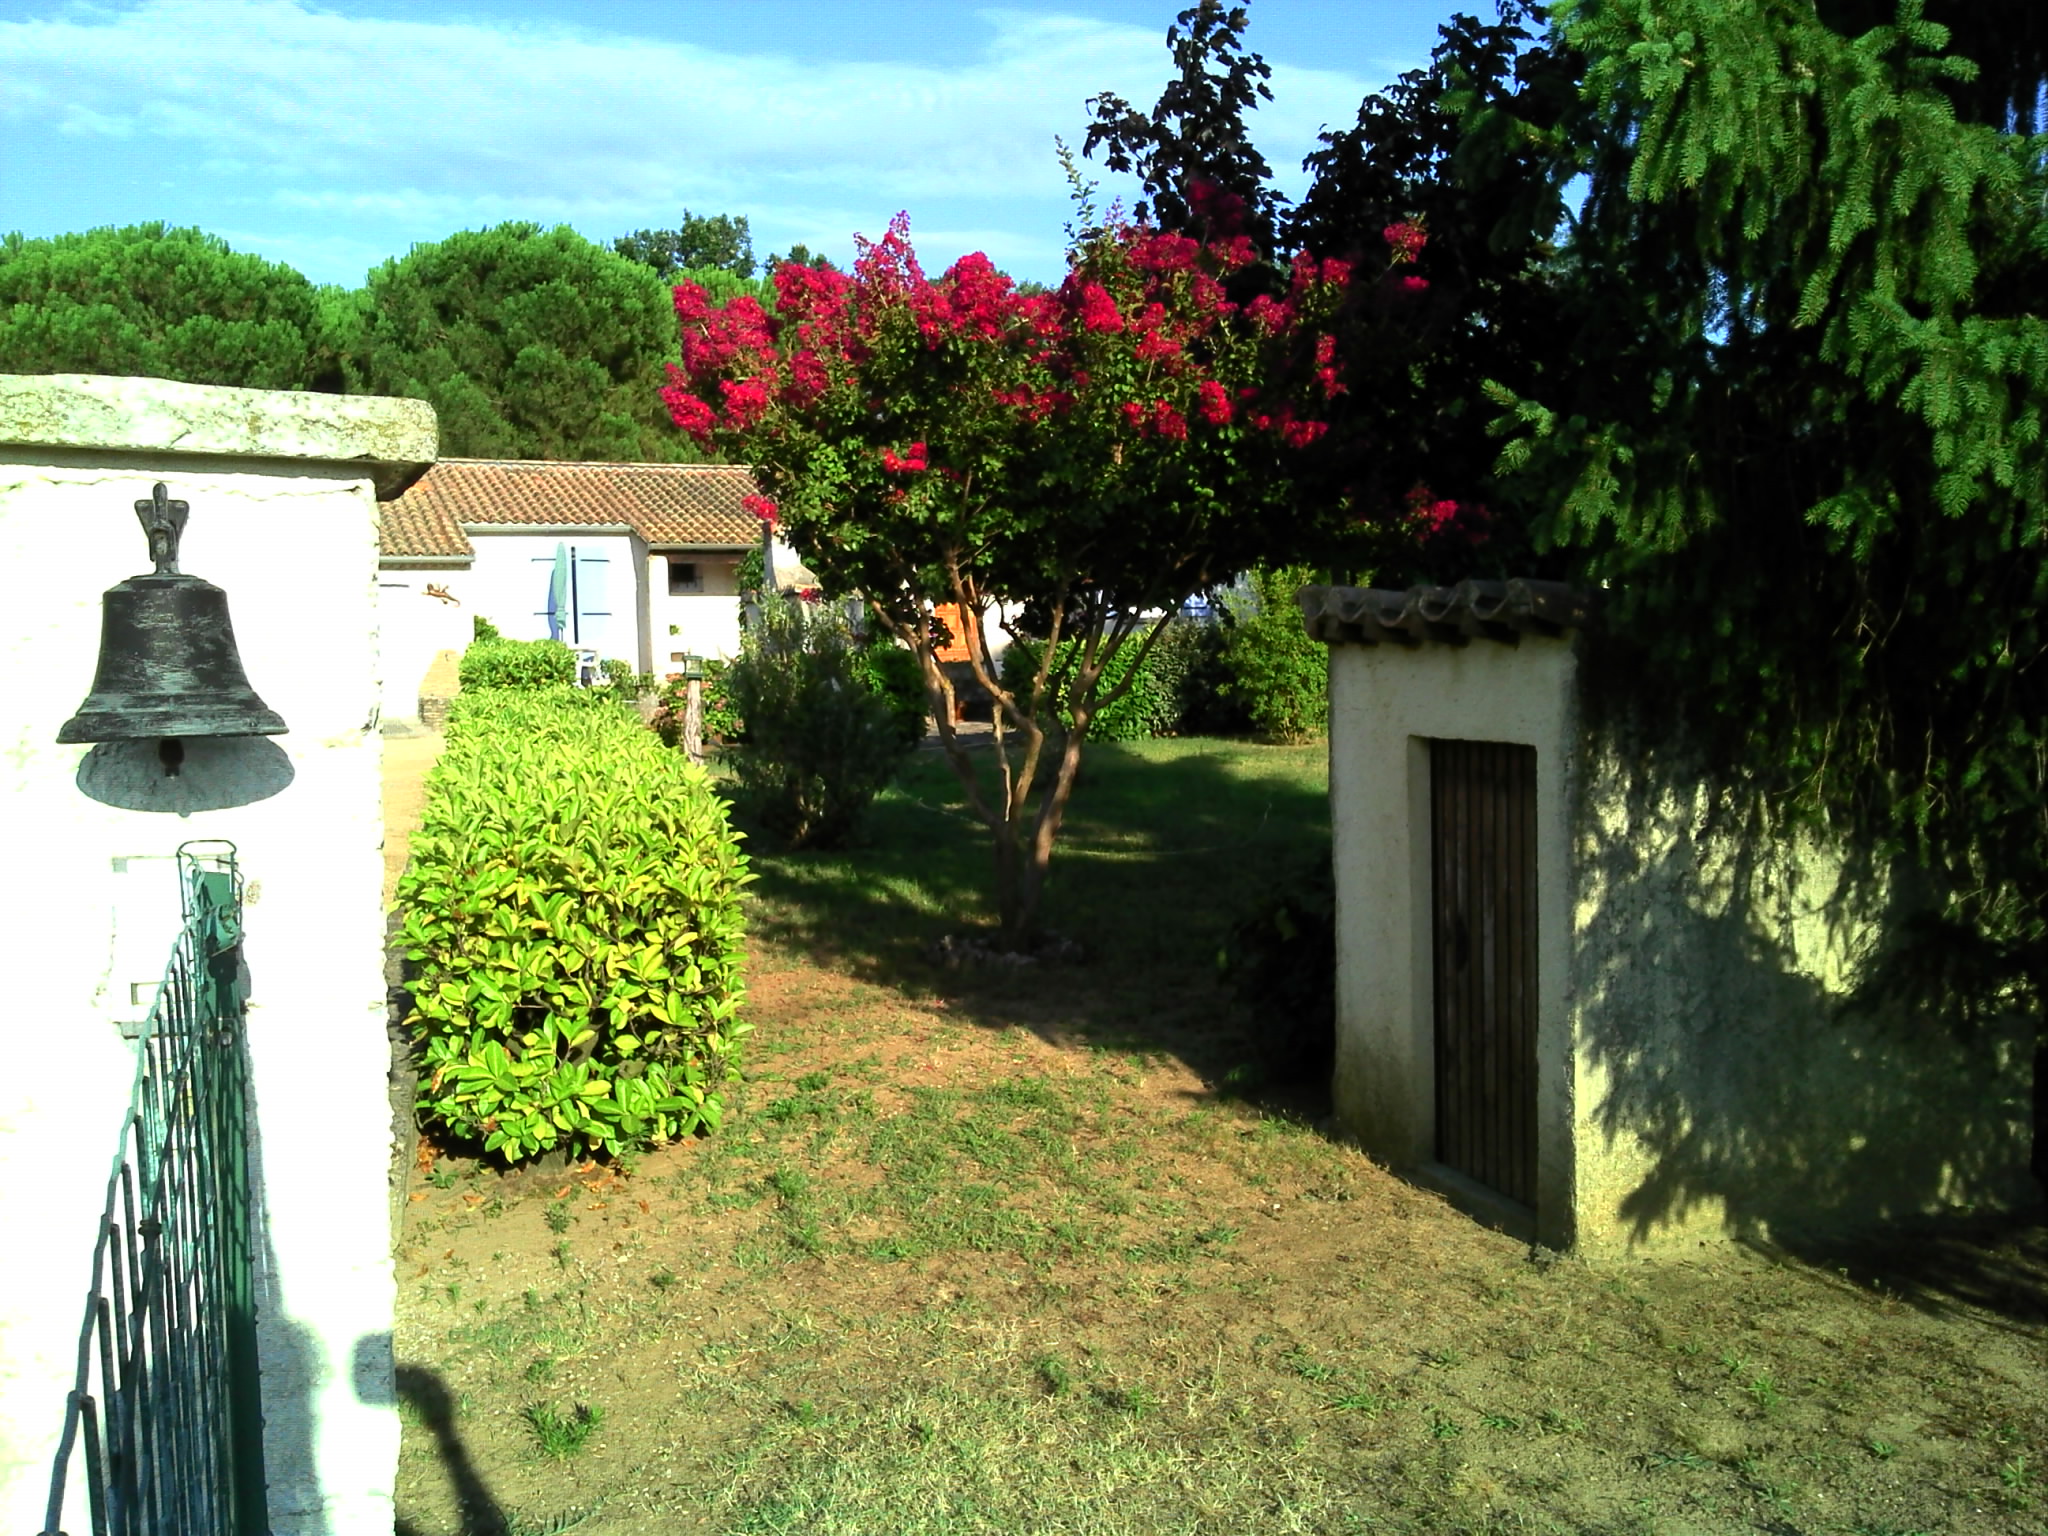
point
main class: Grassland
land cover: Grassland with sparse tree/shrub cover
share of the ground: > 75 %
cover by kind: herbaceous plants 85 %, consolidated bare surface 10 %, broadleaved forest trees 5 %
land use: Residential
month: August
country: FR
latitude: 44.2646
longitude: 4.6085
